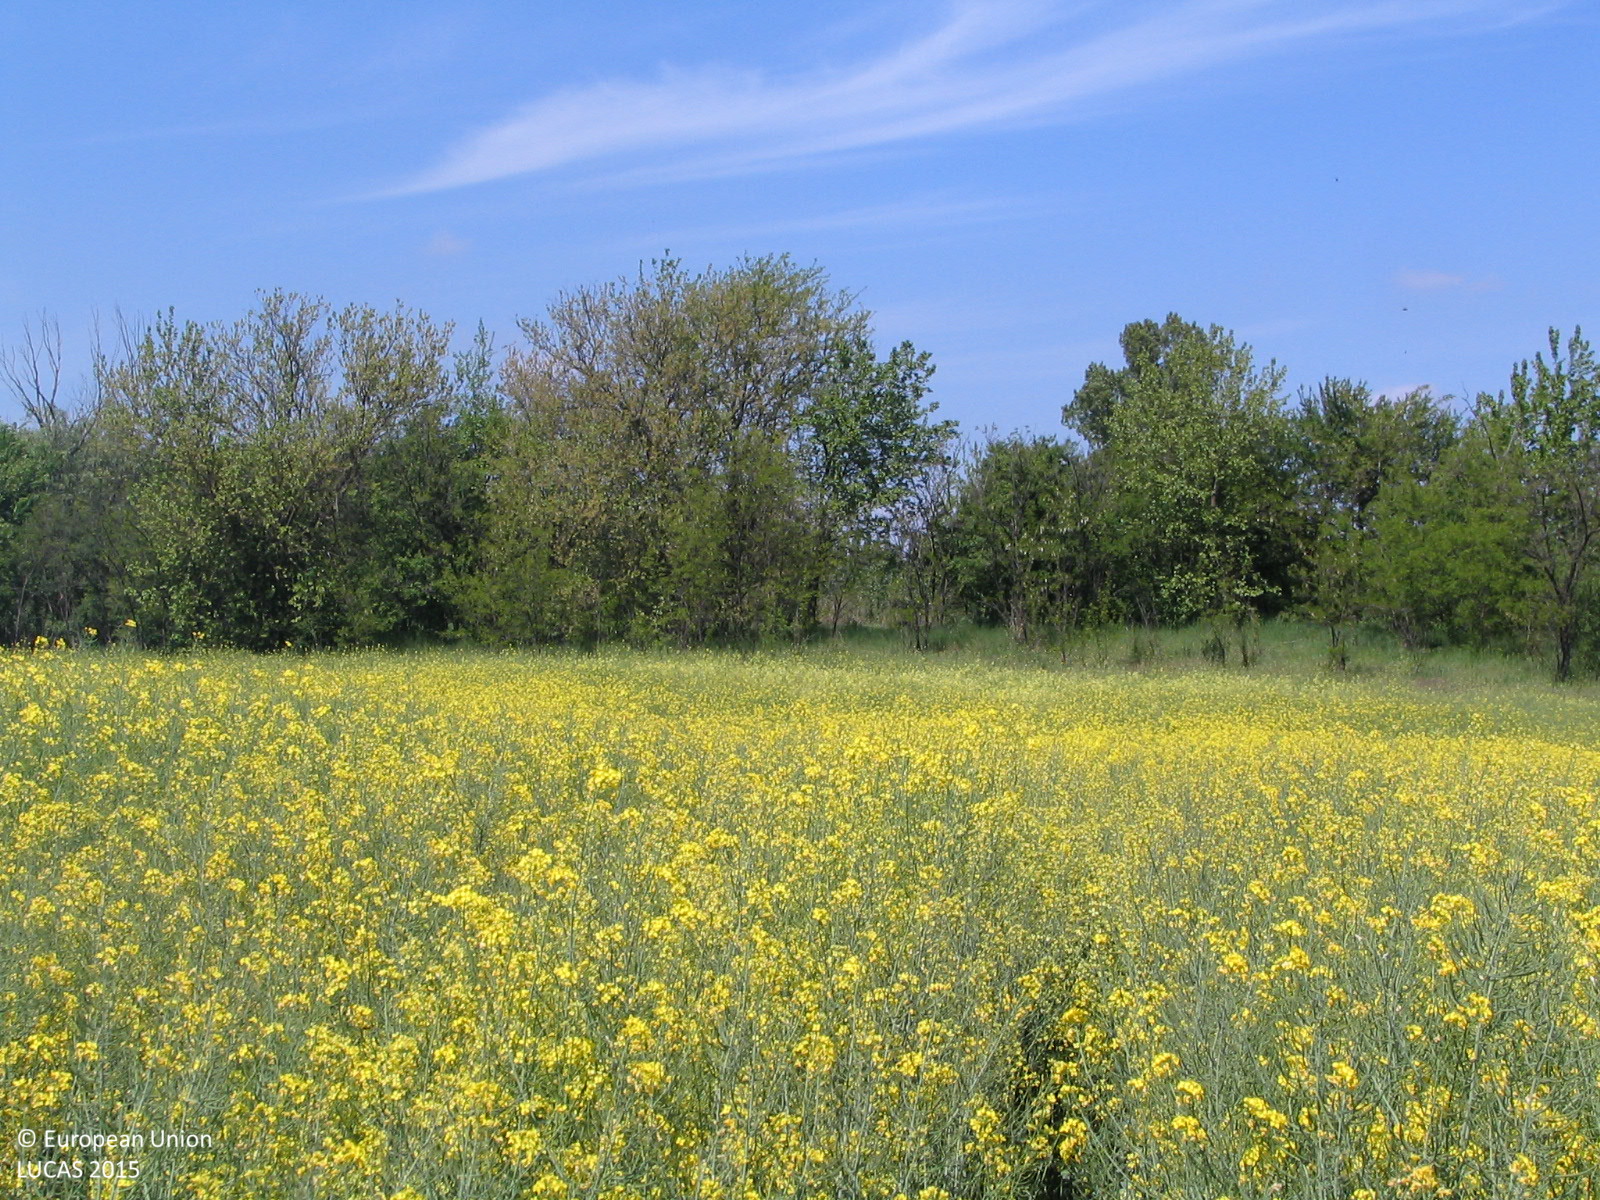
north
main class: Cropland
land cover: Rape and turnip rape
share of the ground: > 75 %
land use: Agriculture (excluding fallow land and kitchen gardens)
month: May
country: BG
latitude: 43.6946
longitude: 24.0889
